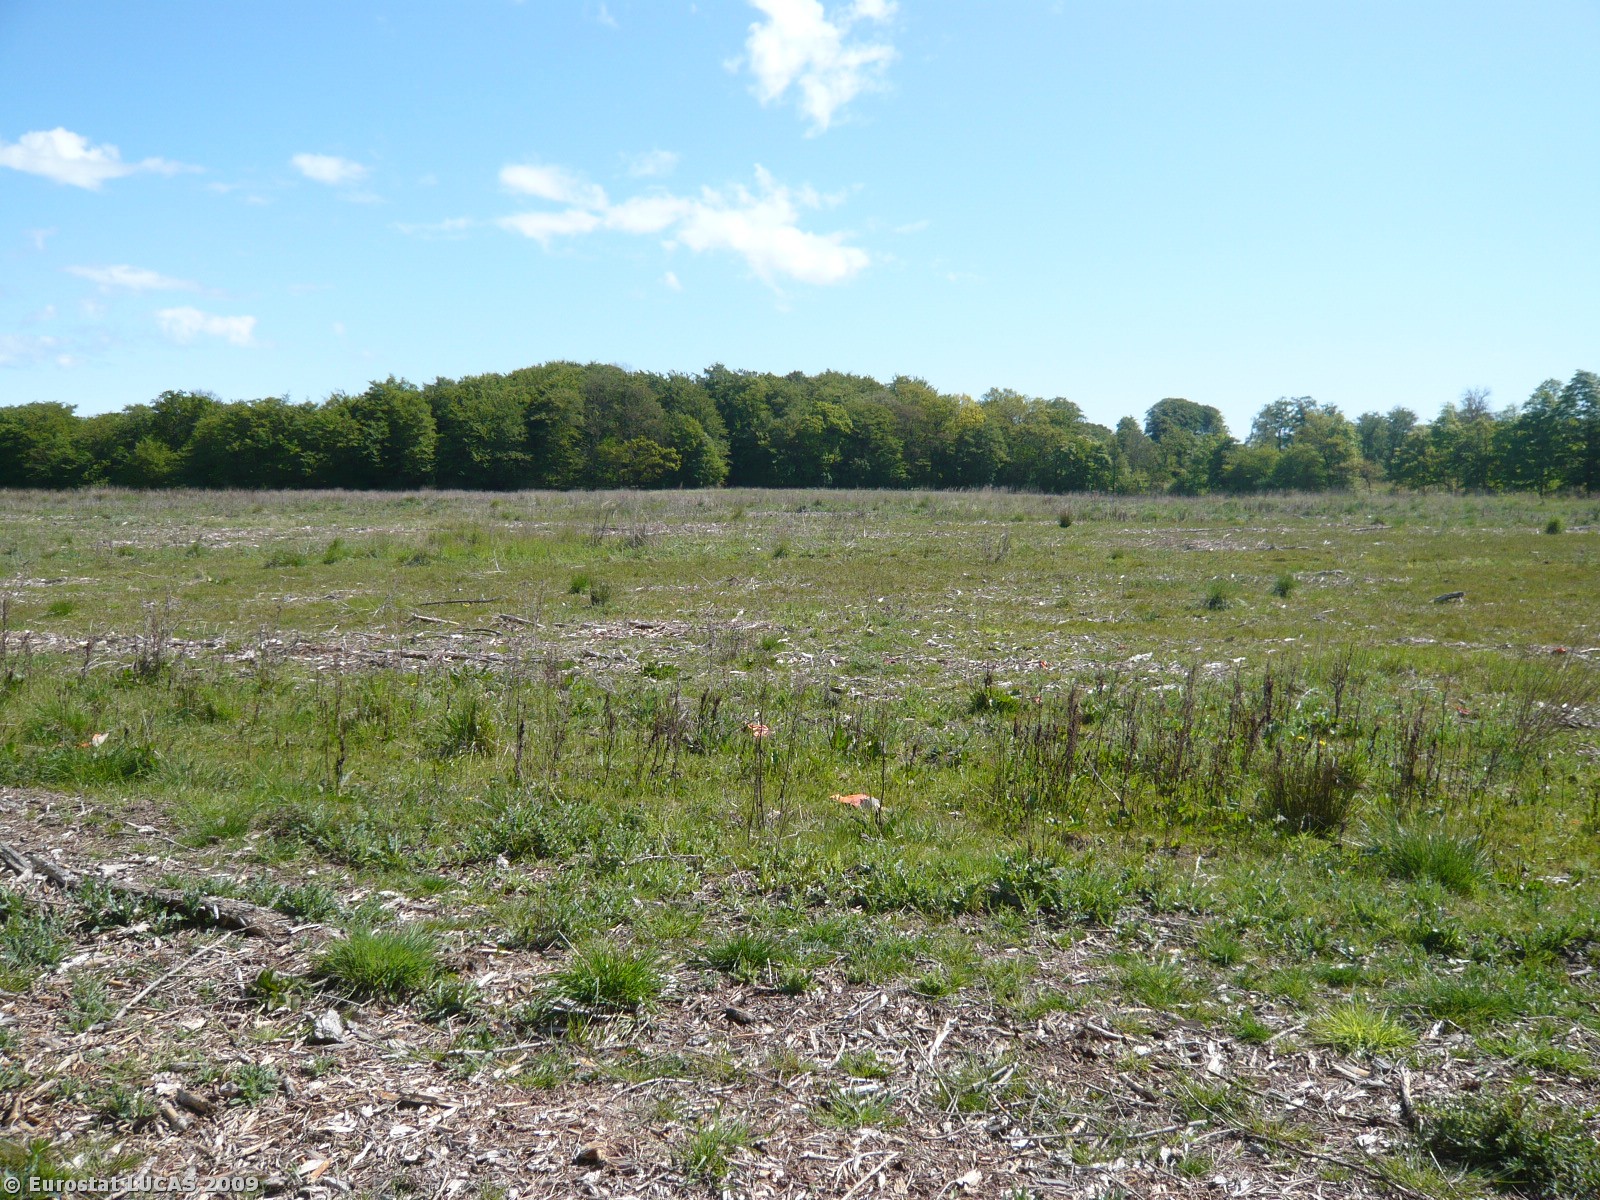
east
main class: Grassland
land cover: Spontaneously vegetated surfaces
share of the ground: 10 - 25 %
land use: Forestry
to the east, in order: Spontaneously vegetated surfaces
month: May
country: DK
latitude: 55.0756
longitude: 11.9878
